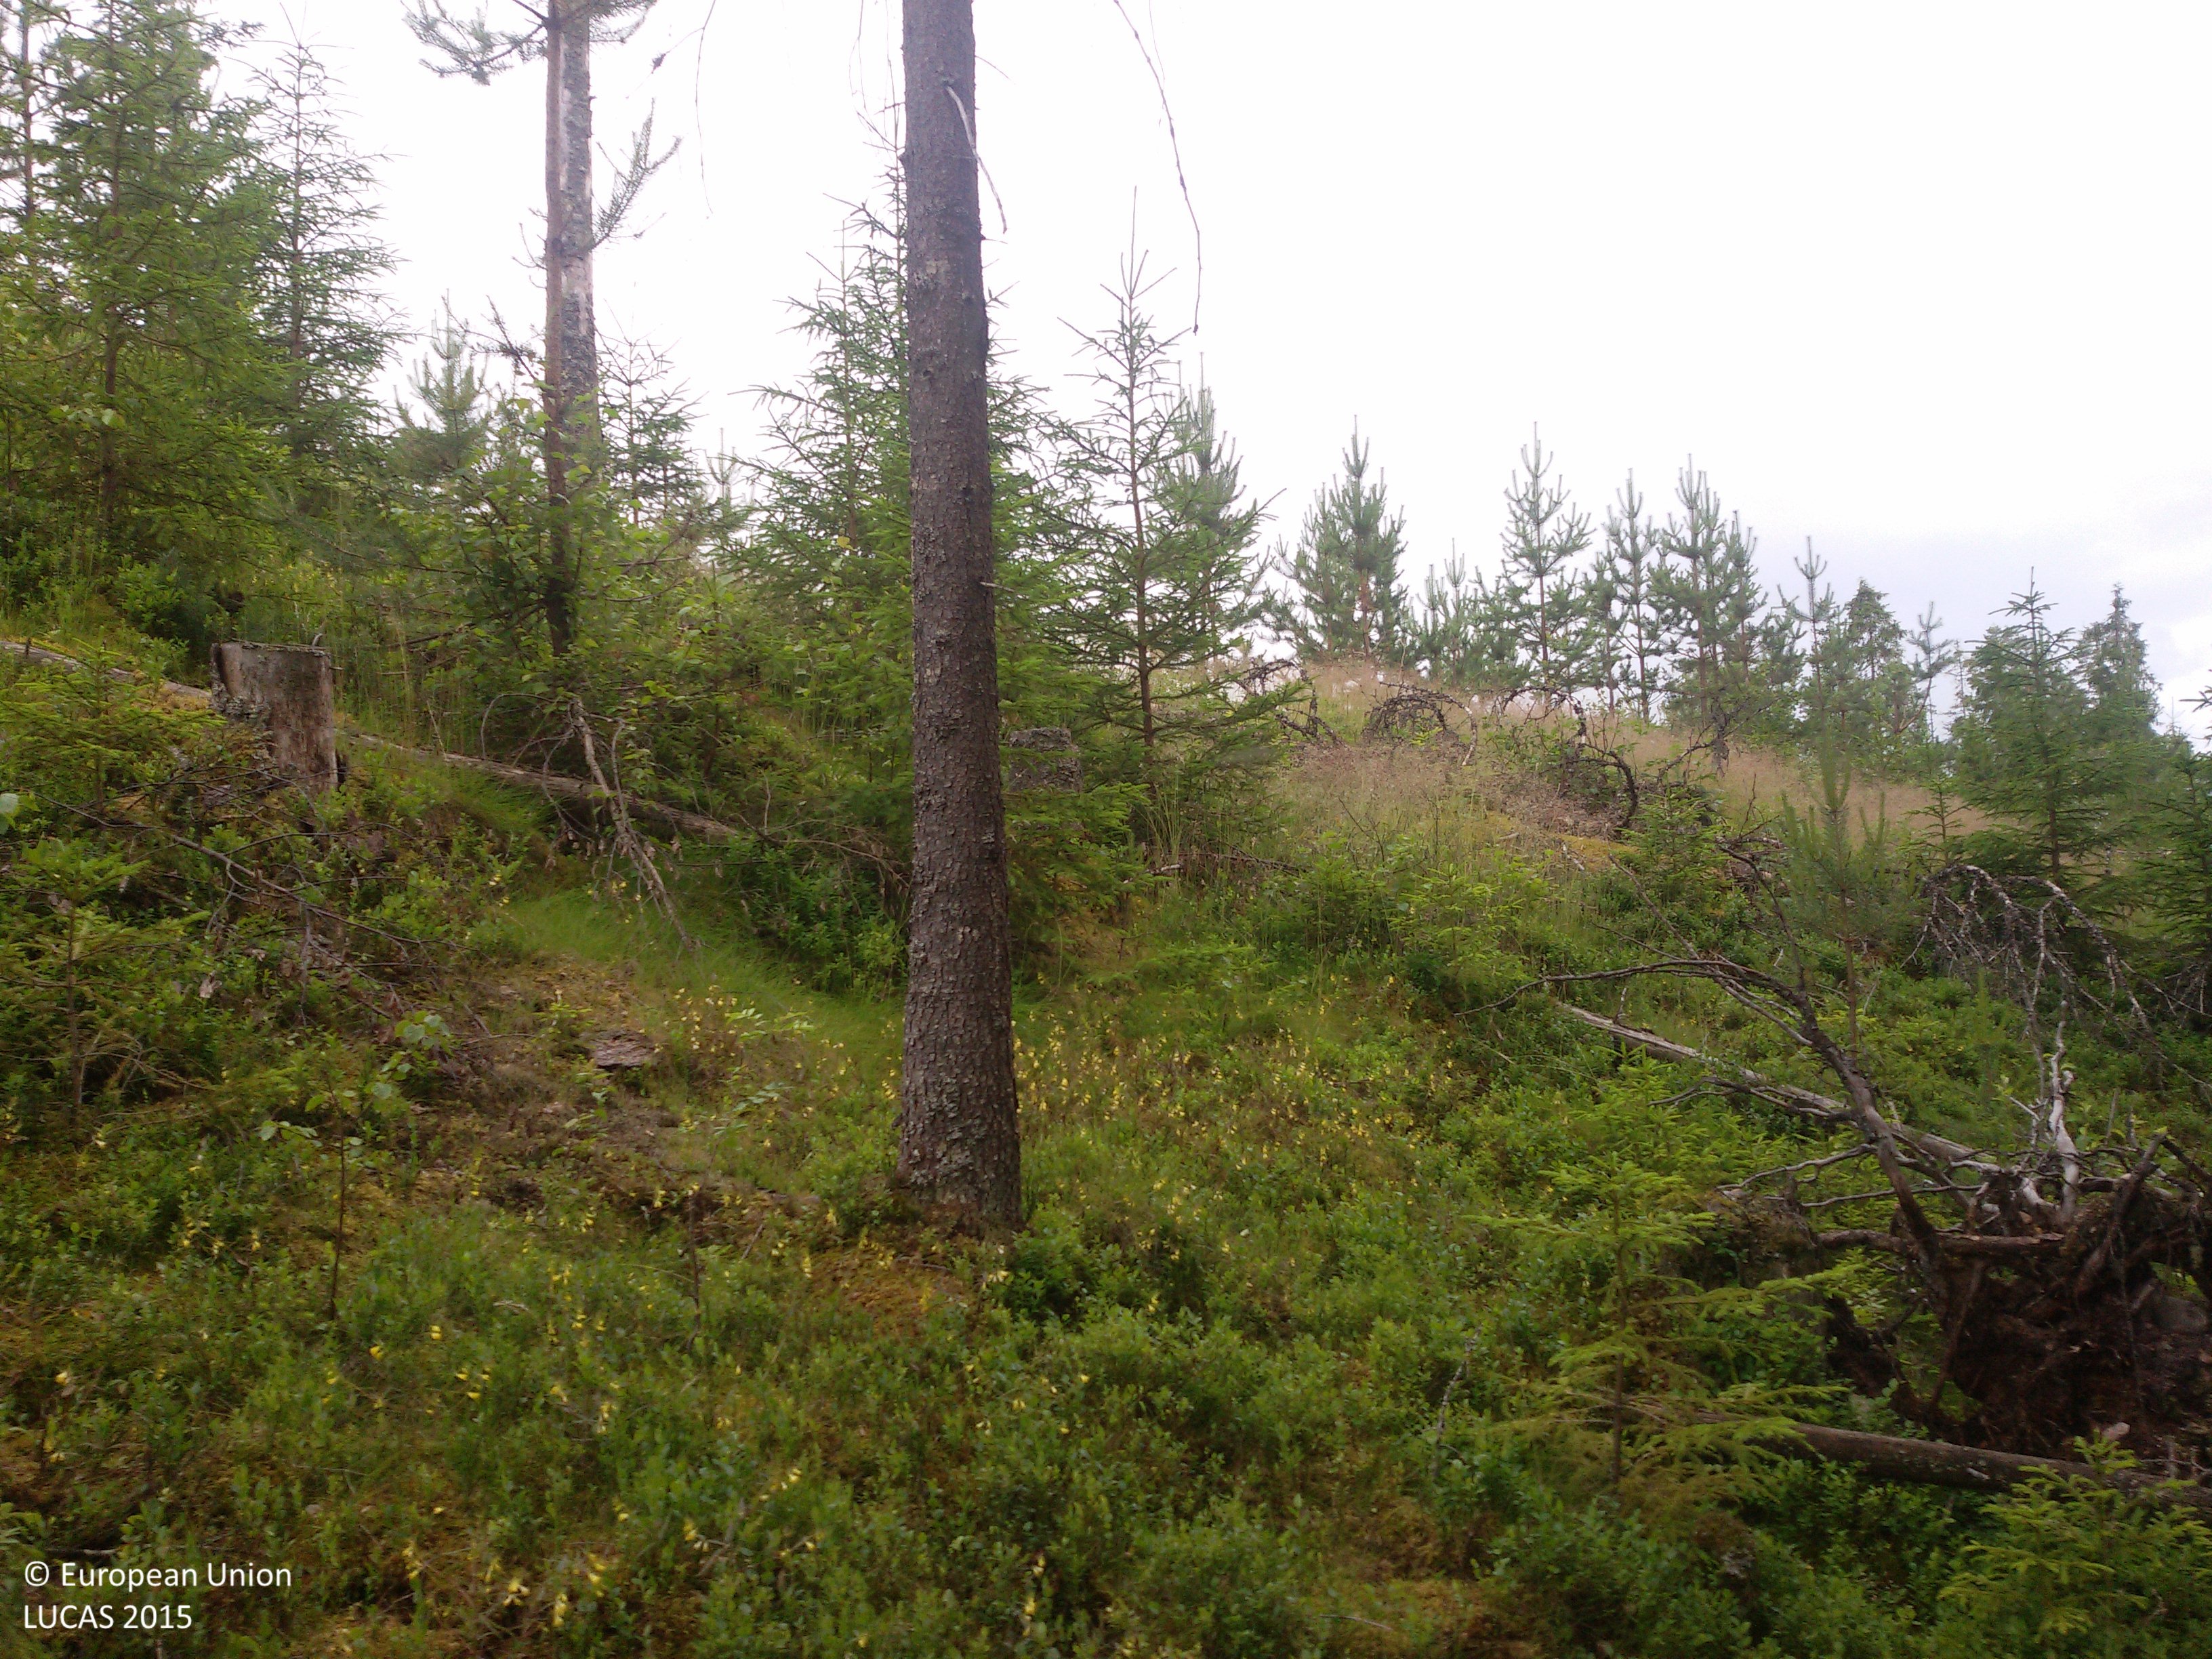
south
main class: Woodland
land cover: Spruce dominated coniferous woodland
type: boreal forest
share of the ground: 50 - 75 %
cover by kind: coniferous forest trees 75 %, shrubs 15 %, herbaceous plants 10 %
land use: Forestry
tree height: > 5 m
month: July
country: SE
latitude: 60.4008
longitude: 14.9431
